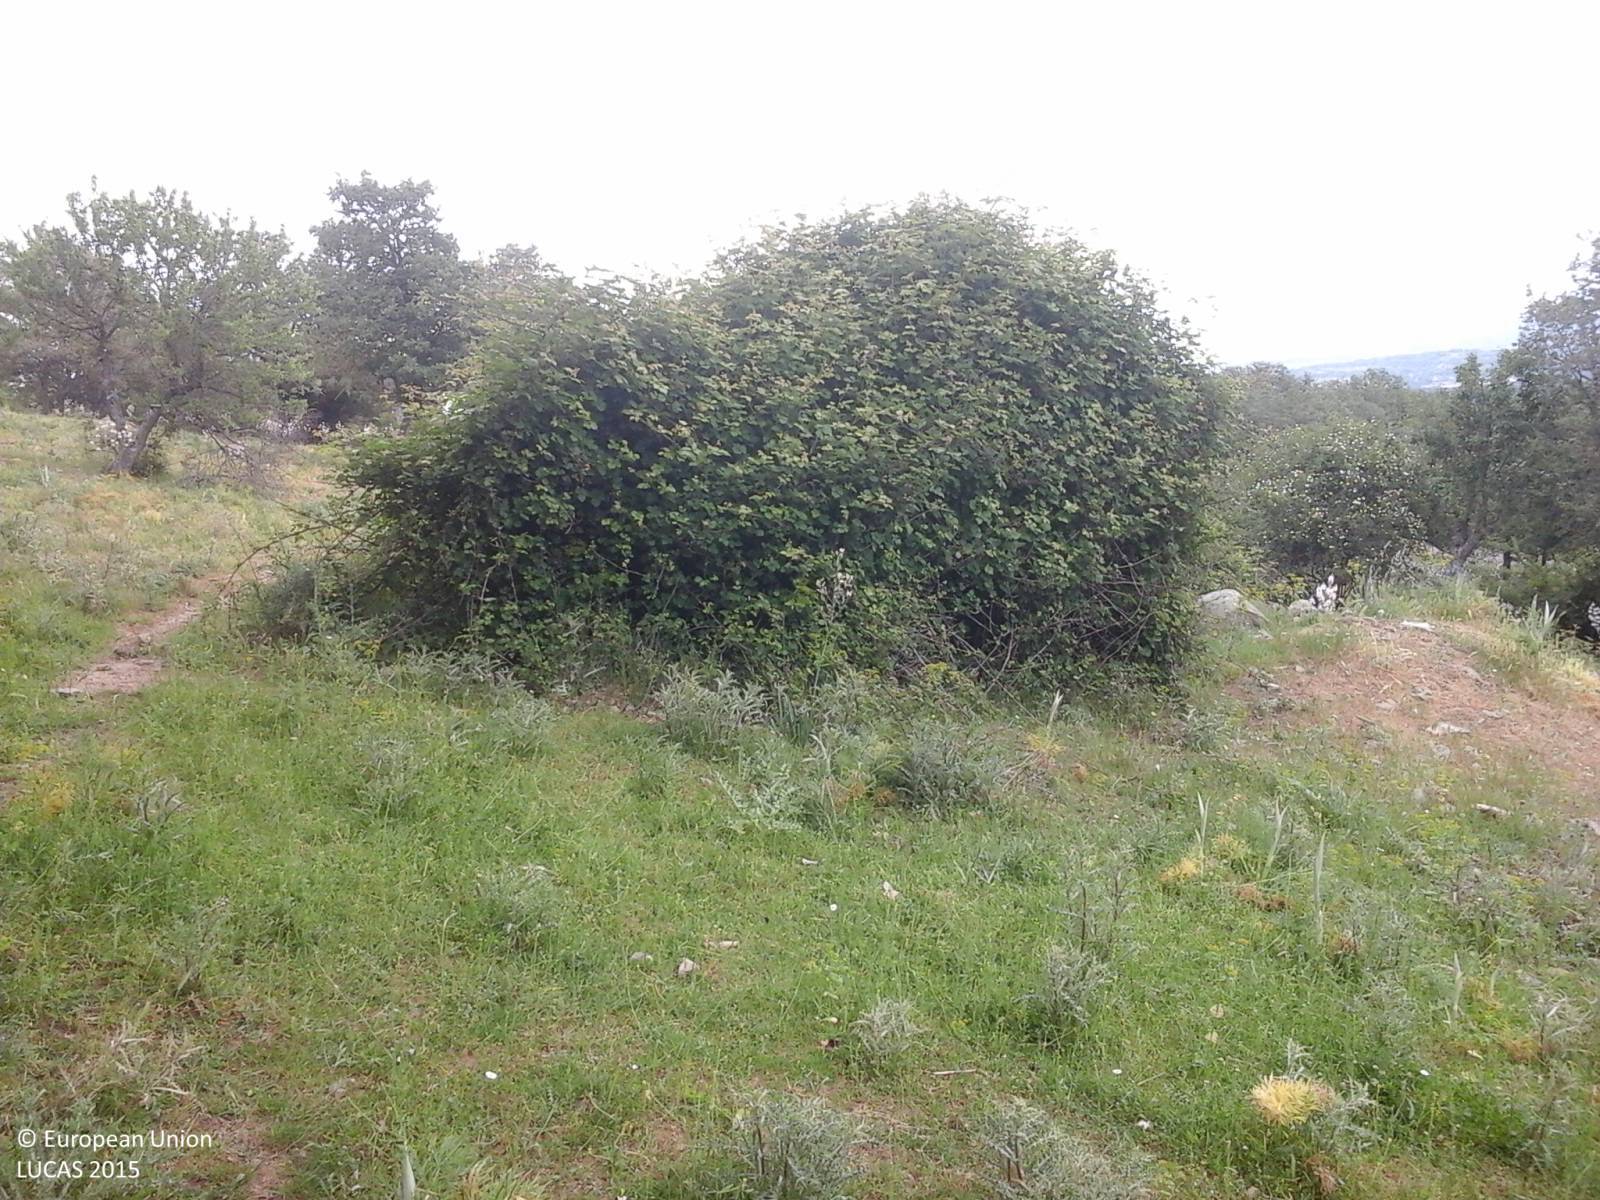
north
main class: Grassland
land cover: Grassland with sparse tree/shrub cover
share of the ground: 50 - 75 %
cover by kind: herbaceous plants 85 %, shrubs 10 %, broadleaved forest trees 5 %
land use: Agriculture (excluding fallow land and kitchen gardens)
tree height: > 5 m
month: May
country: IT
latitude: 40.1201
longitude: 9.3114
